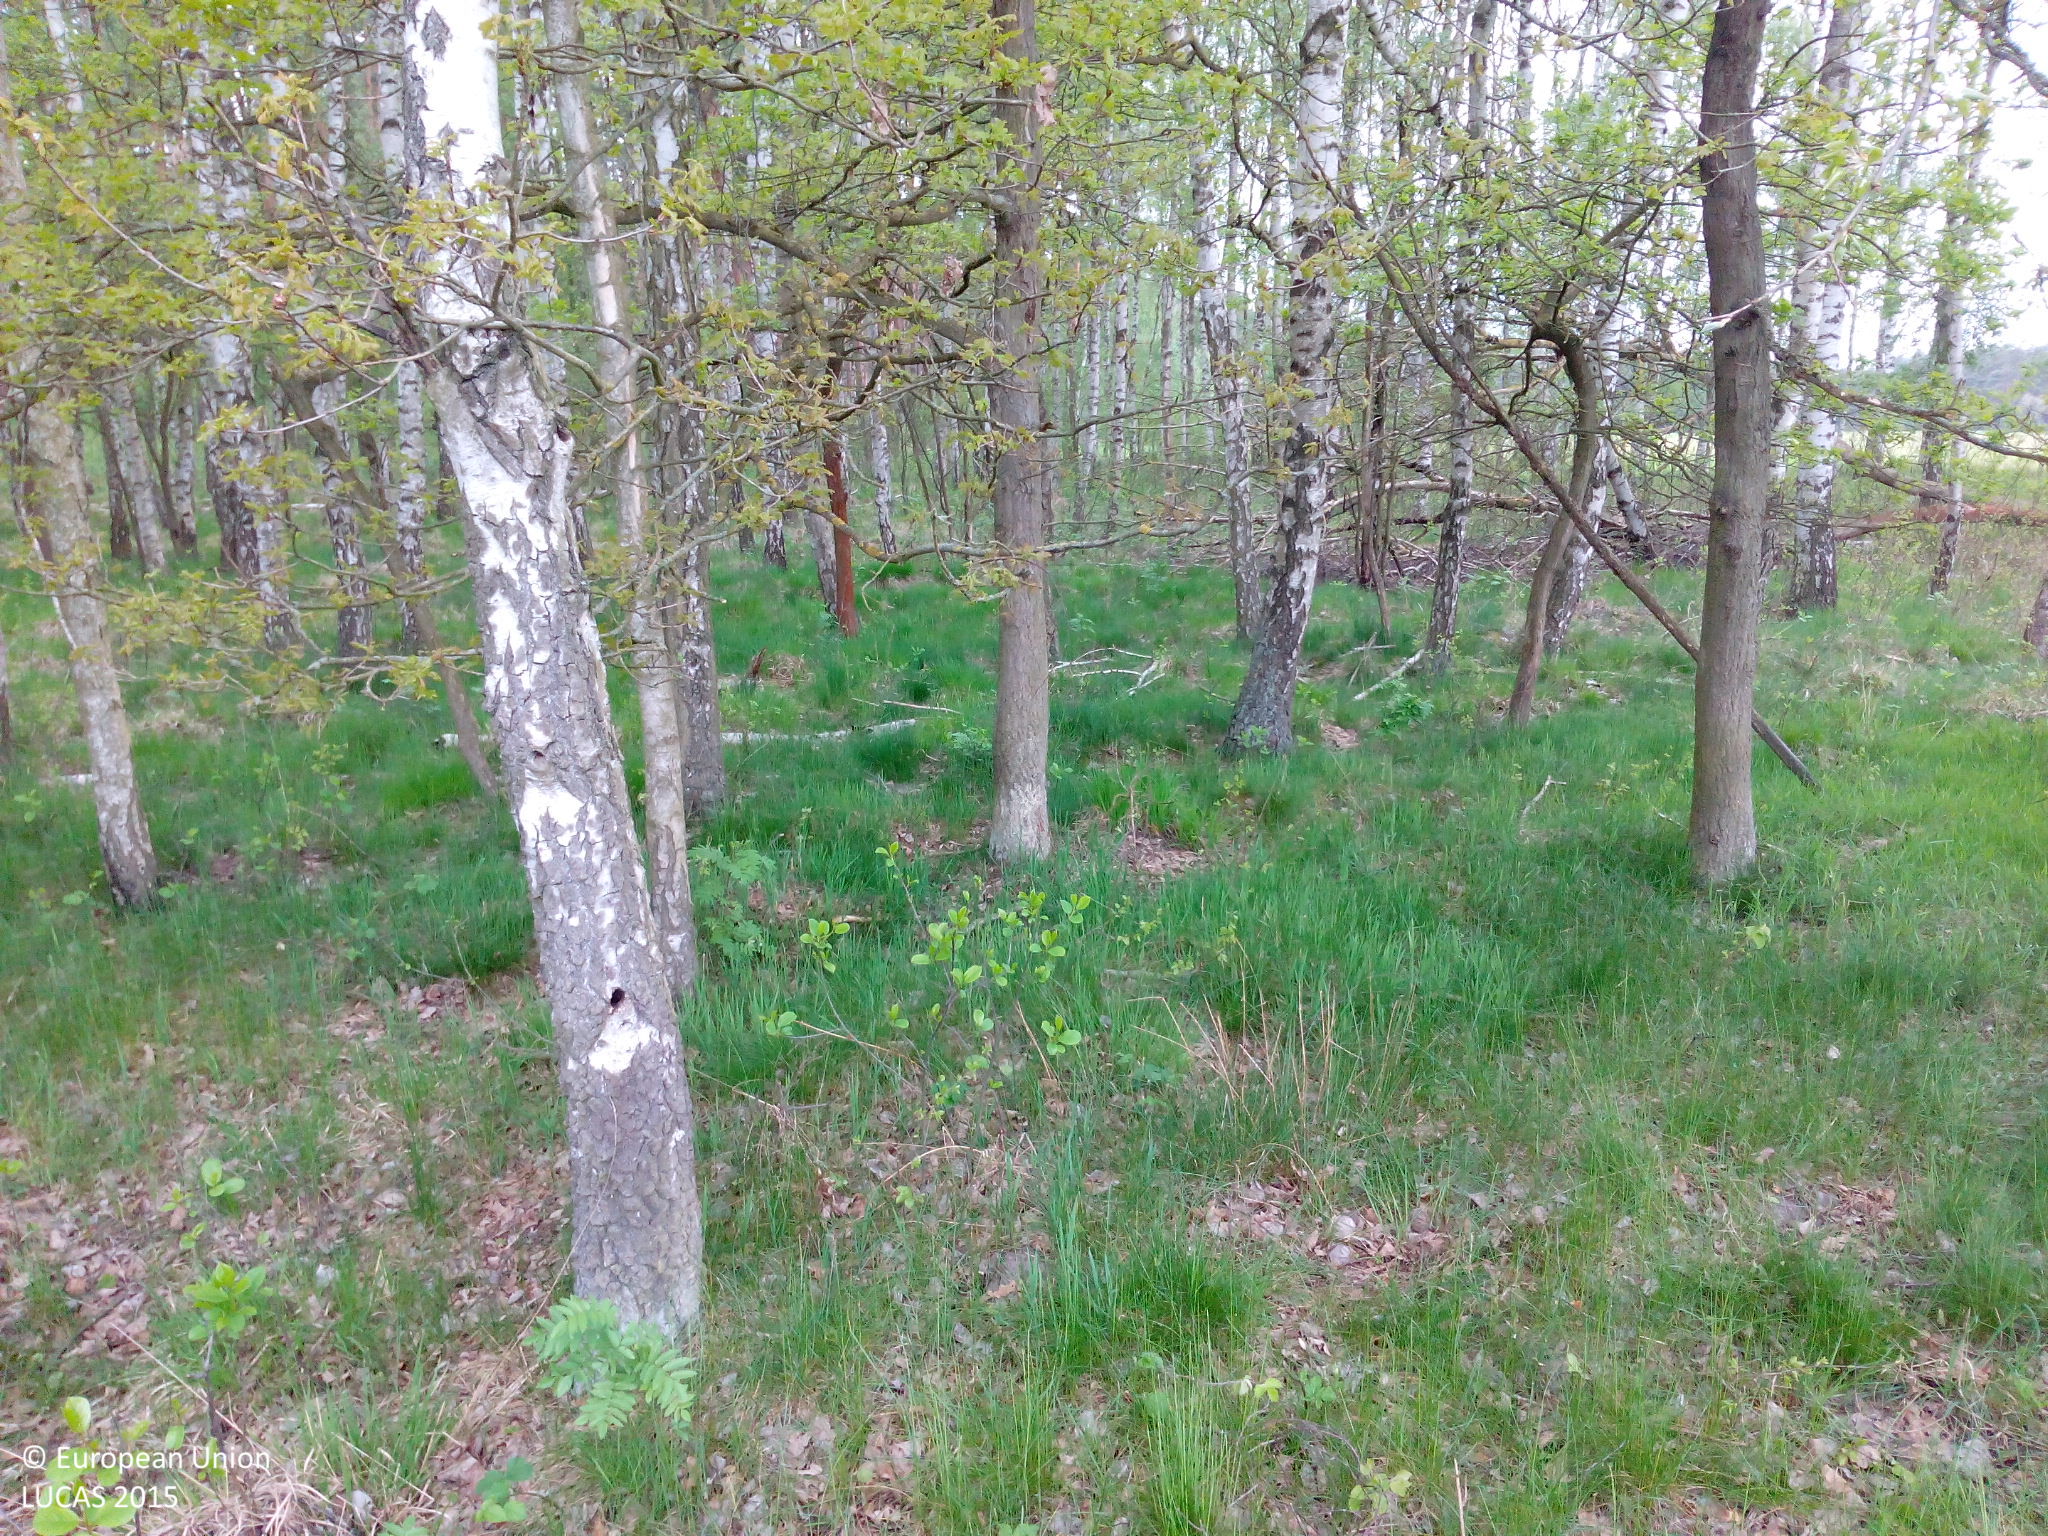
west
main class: Woodland
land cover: Broadleaved woodland
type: non-riverine alder, birch or aspen forest
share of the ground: 50 - 75 %
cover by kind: broadleaved forest trees 70 %, herbaceous plants 30 %
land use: Forestry
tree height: > 5 m
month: May
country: DE
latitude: 52.9057
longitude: 11.6201
